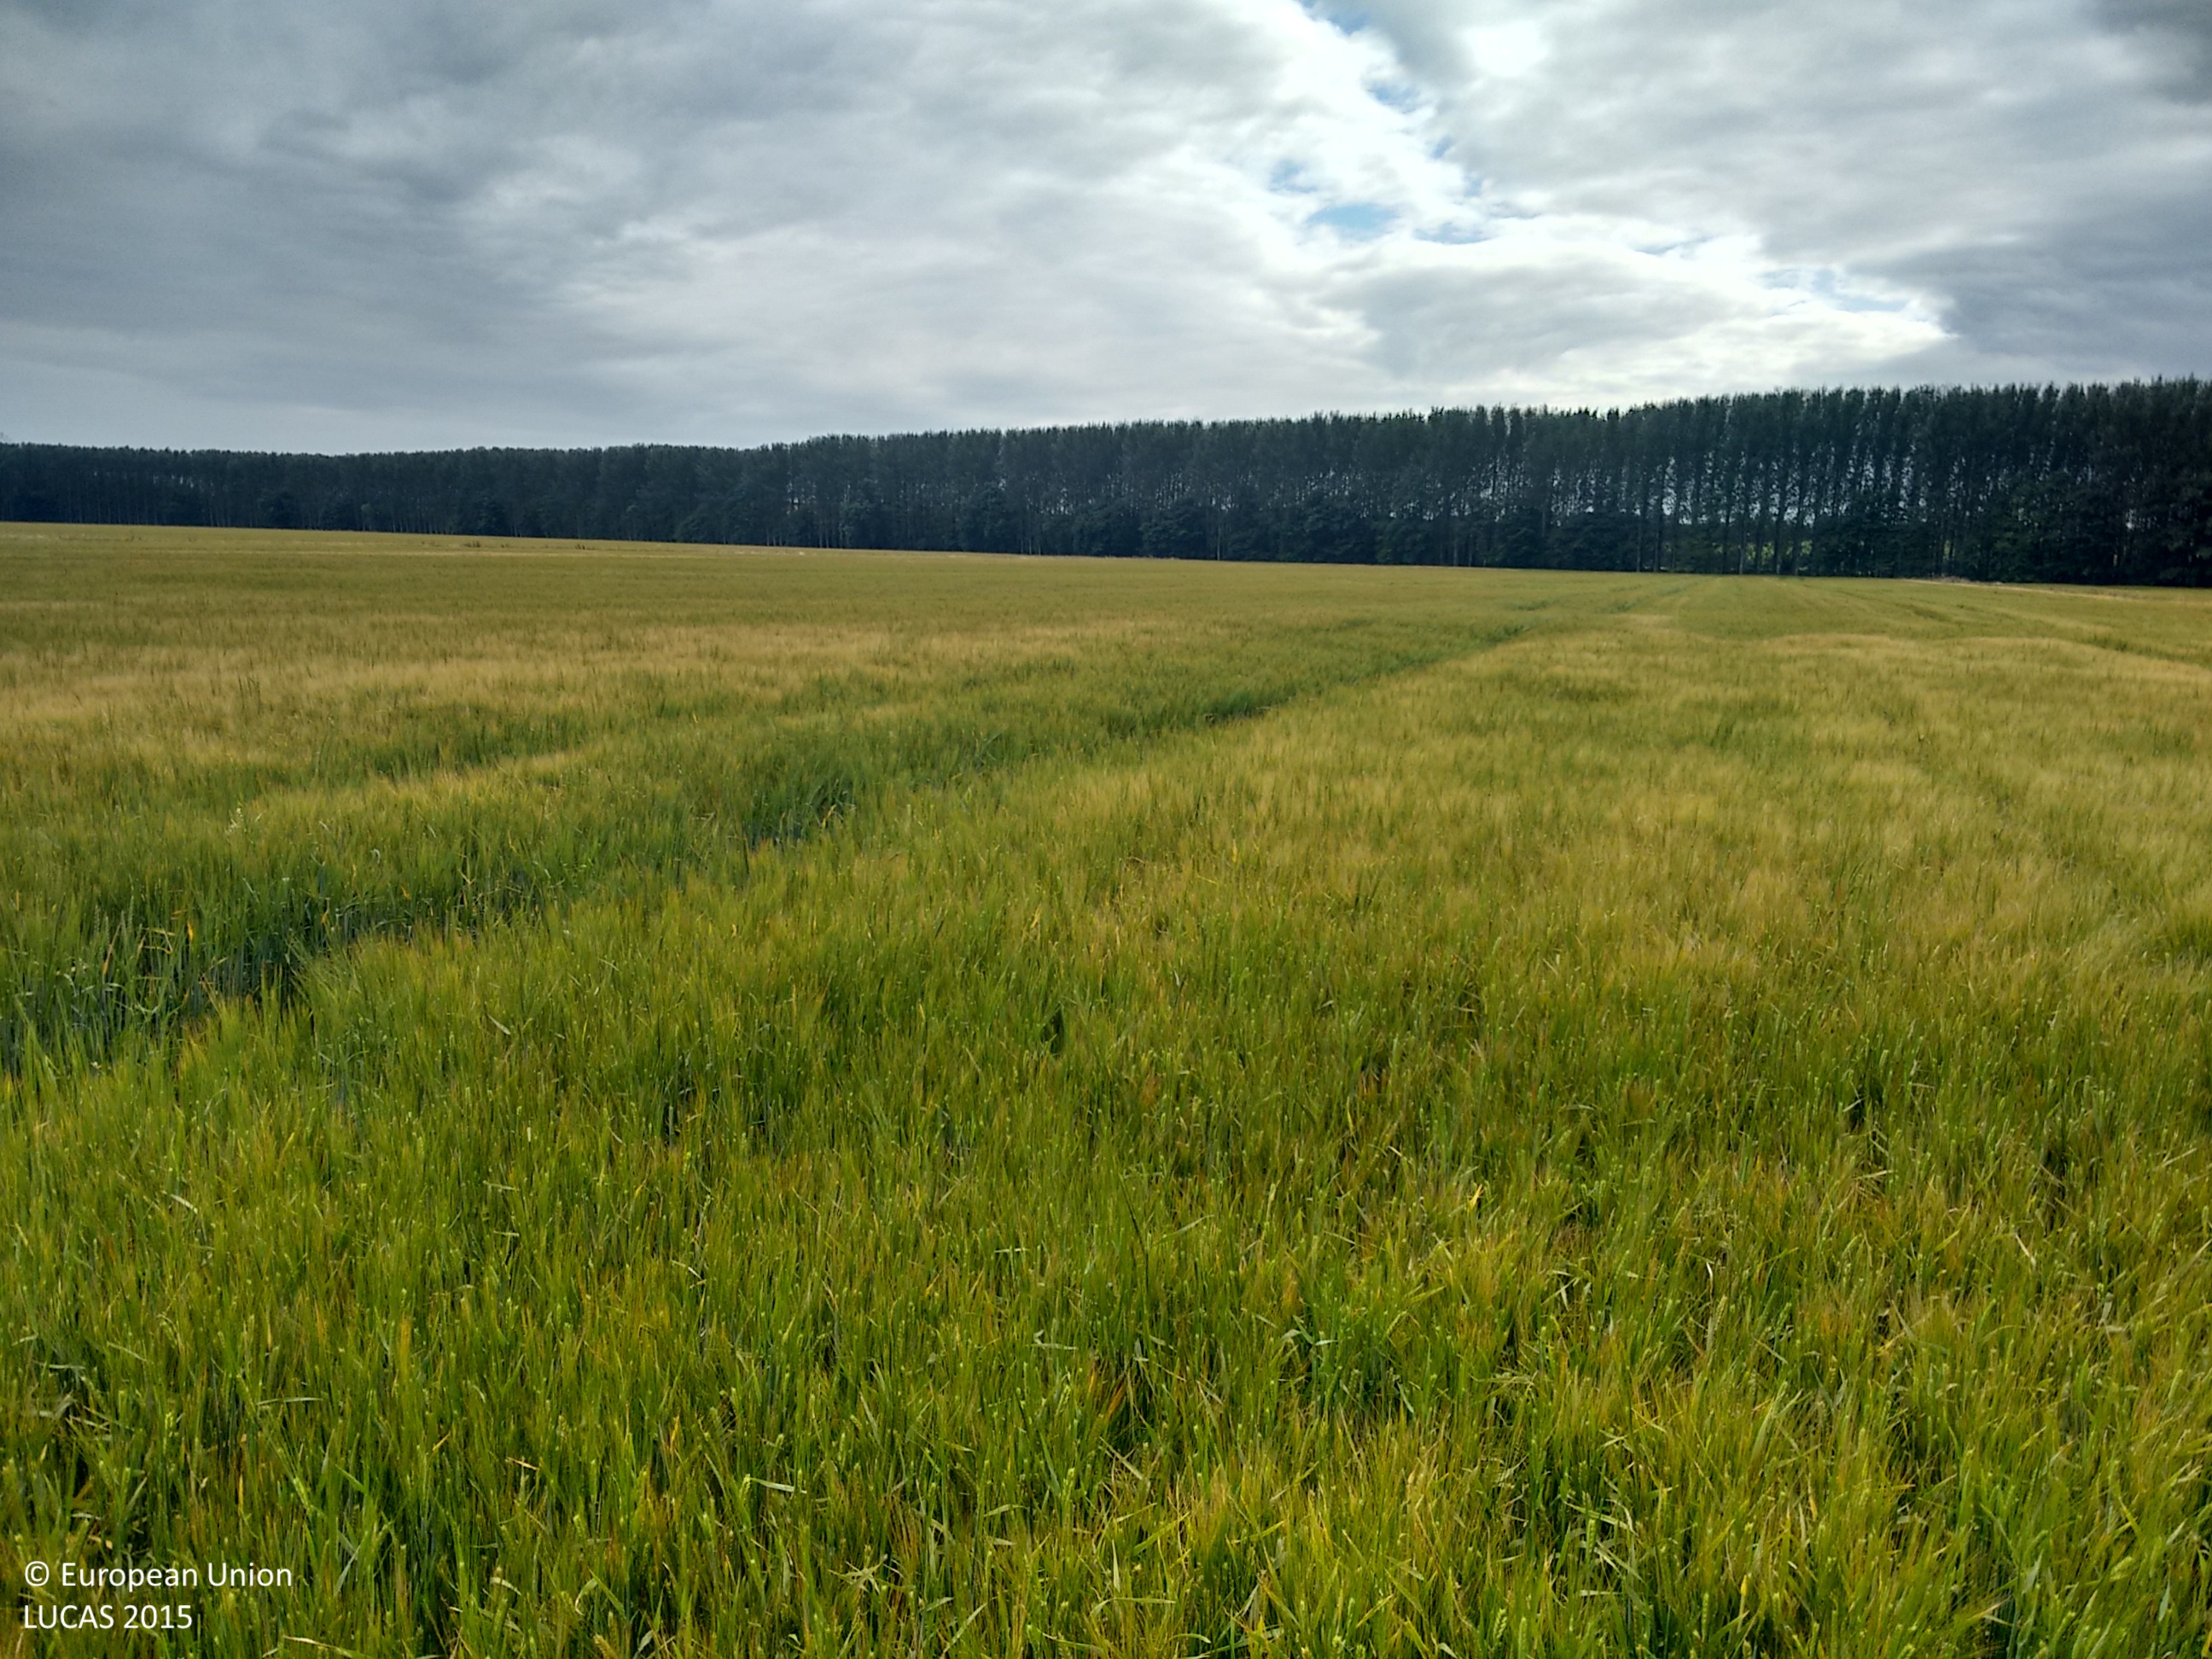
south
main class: Cropland
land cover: Common wheat
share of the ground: > 75 %
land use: Agriculture (excluding fallow land and kitchen gardens)
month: August
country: IE
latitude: 53.8831
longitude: -6.4479
